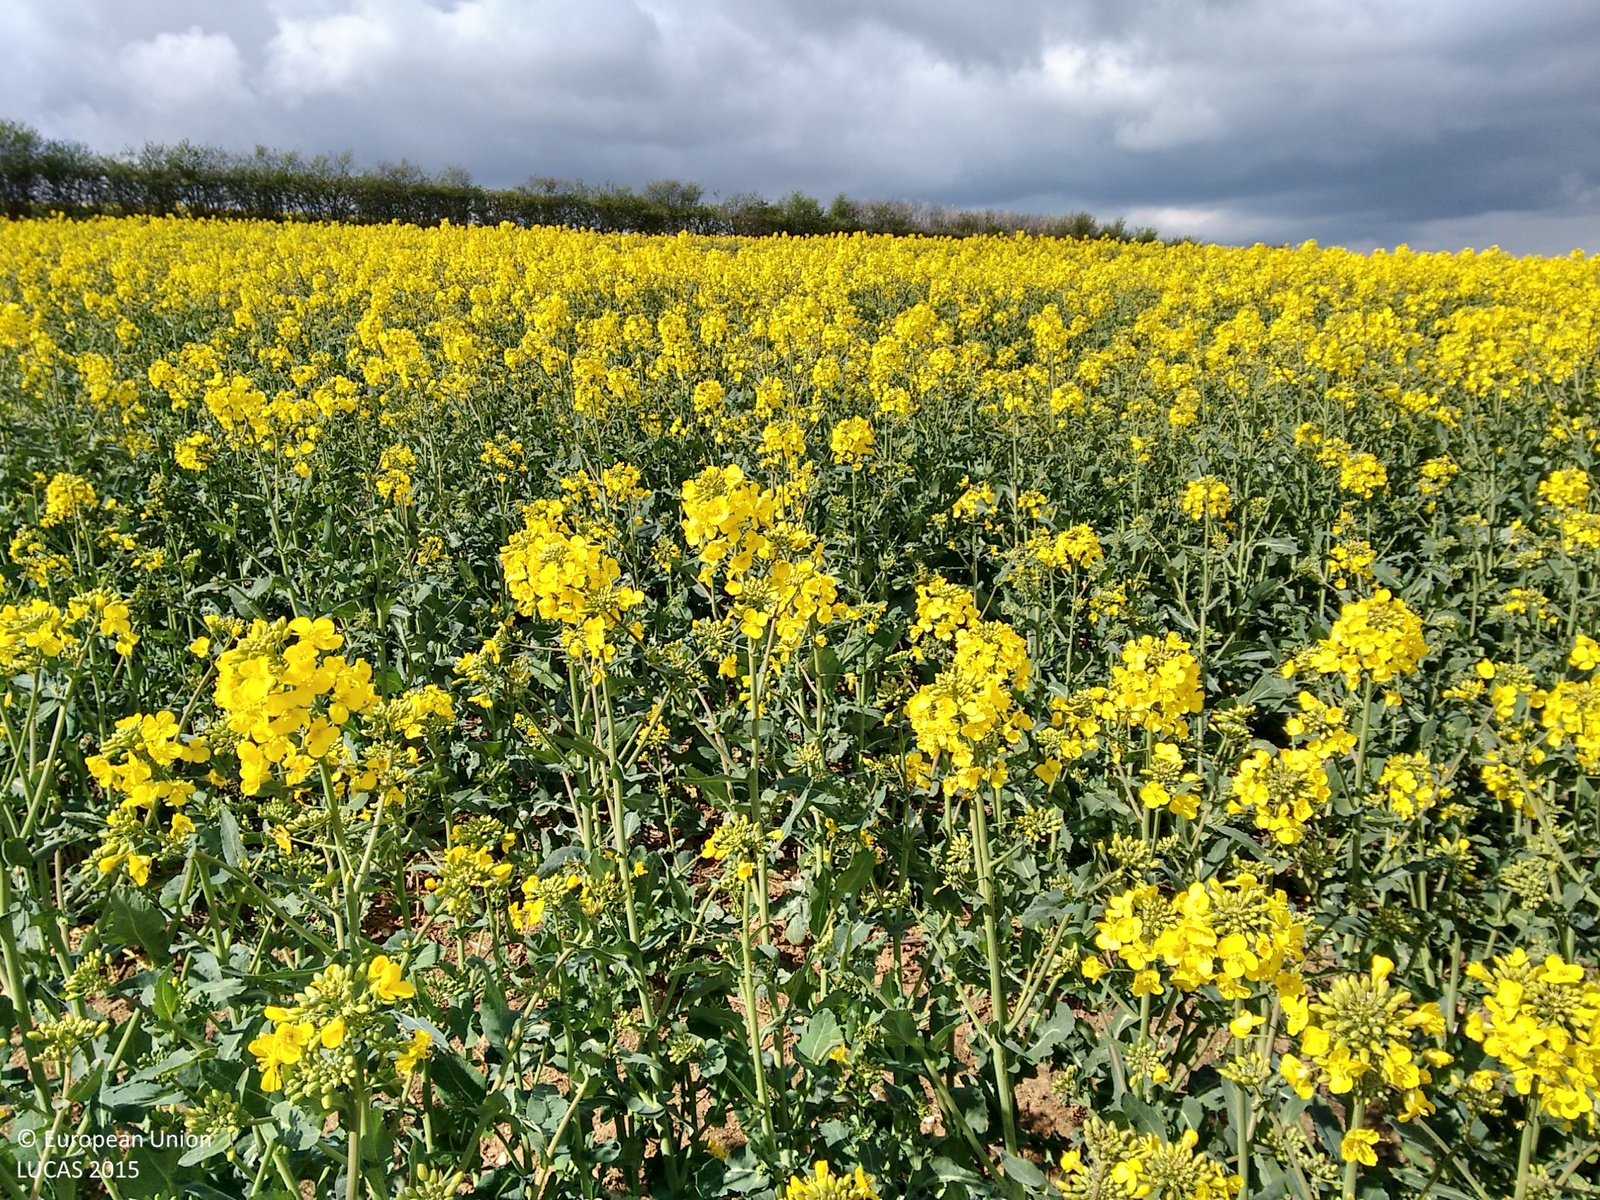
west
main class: Cropland
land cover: Rape and turnip rape
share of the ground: > 75 %
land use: Agriculture (excluding fallow land and kitchen gardens)
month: April
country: GB
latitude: 53.2538
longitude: -0.0600
